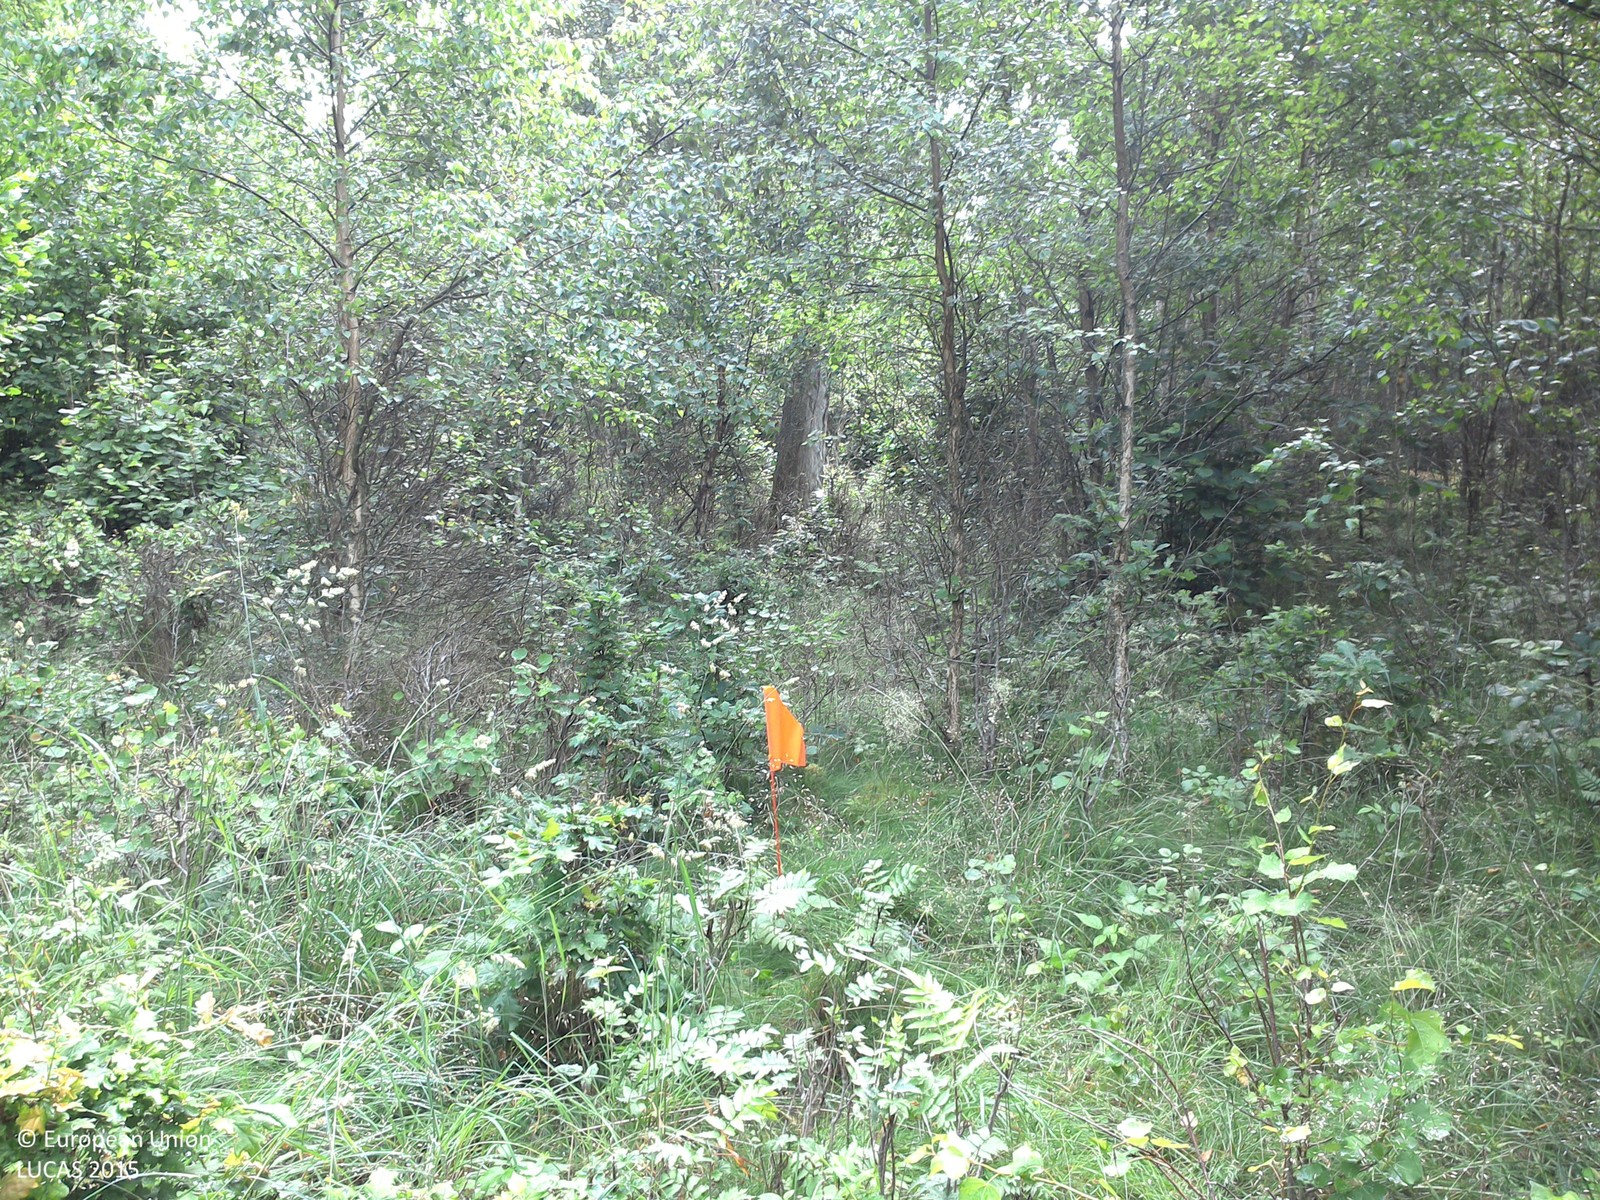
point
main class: Woodland
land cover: Broadleaved woodland
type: boreal forest
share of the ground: > 75 %
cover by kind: broadleaved forest trees 80 %, herbaceous plants 20 %
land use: Forestry
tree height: > 5 m
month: July
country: SE
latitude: 58.2761
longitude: 14.8536
